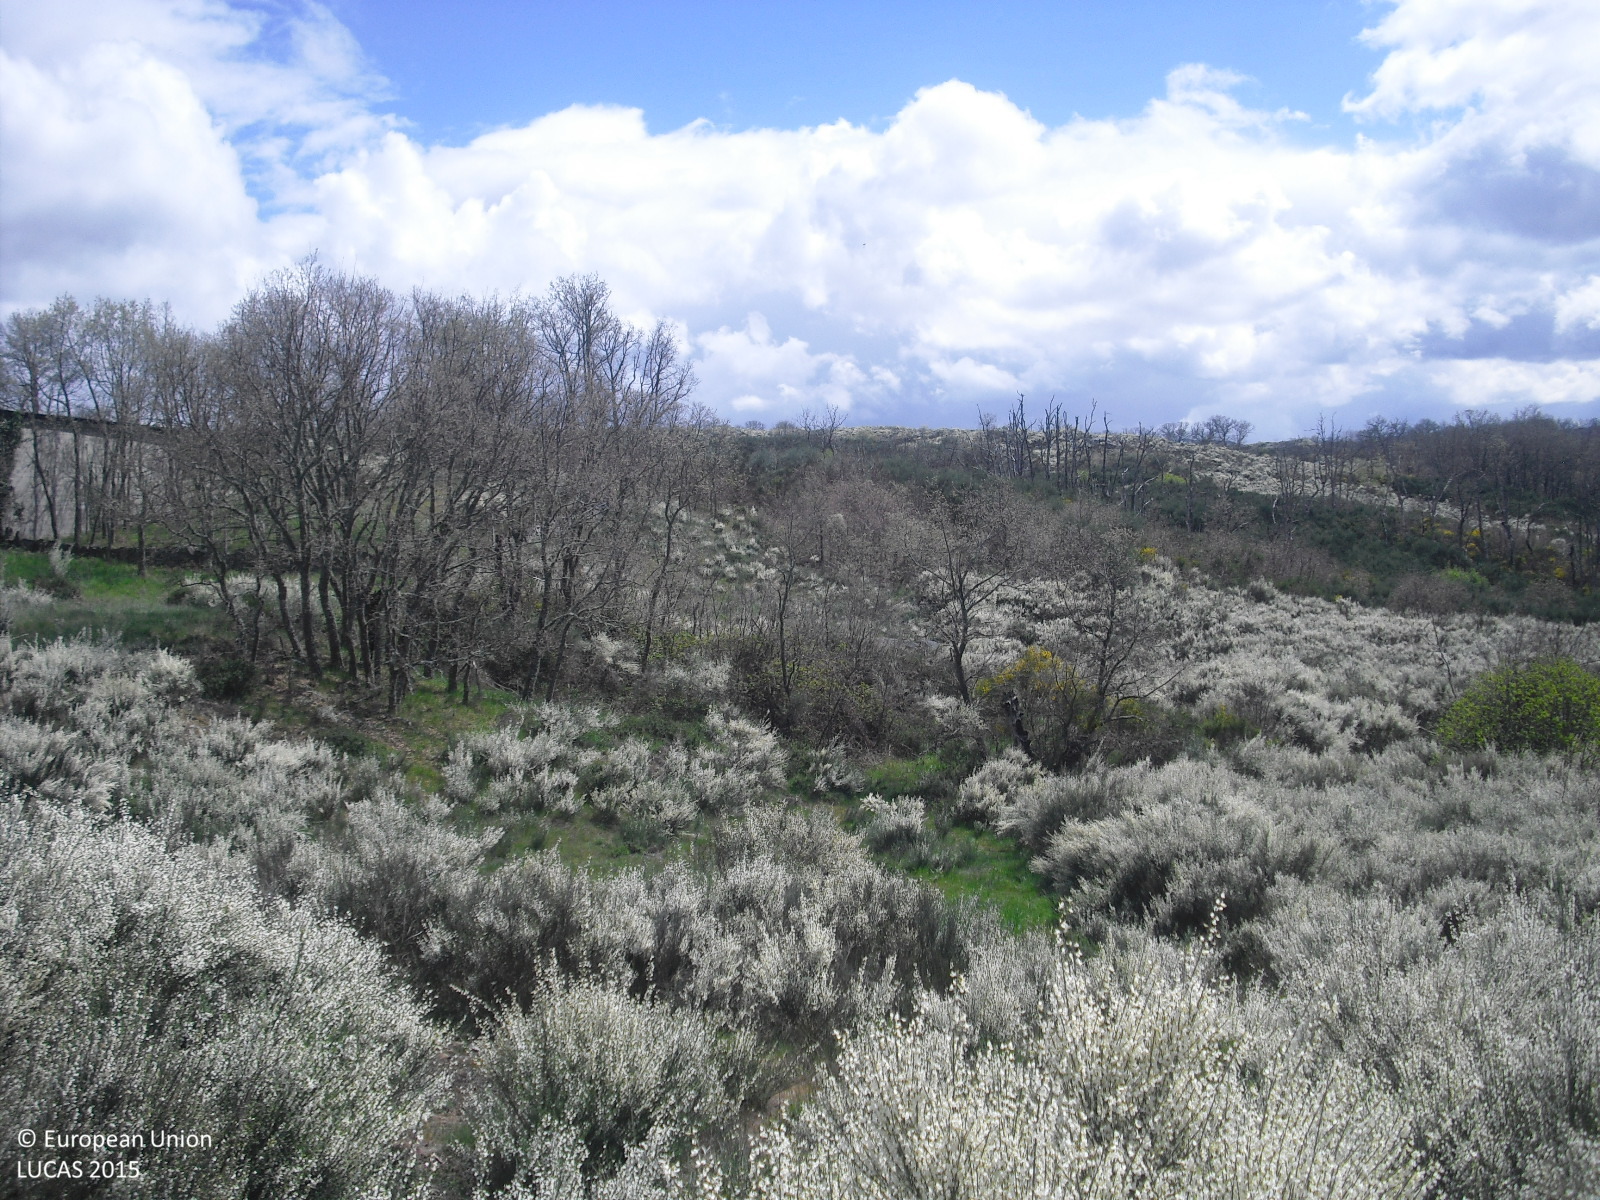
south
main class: Shrubland
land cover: Shrubland with sparse tree cover
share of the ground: 50 - 75 %
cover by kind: shrubs 70 %, herbaceous plants 15 %, consolidated bare surface 10 %, broadleaved forest trees 5 %
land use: Semi-natural and natural areas not in use
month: April
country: ES
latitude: 41.8565
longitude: -7.5894
